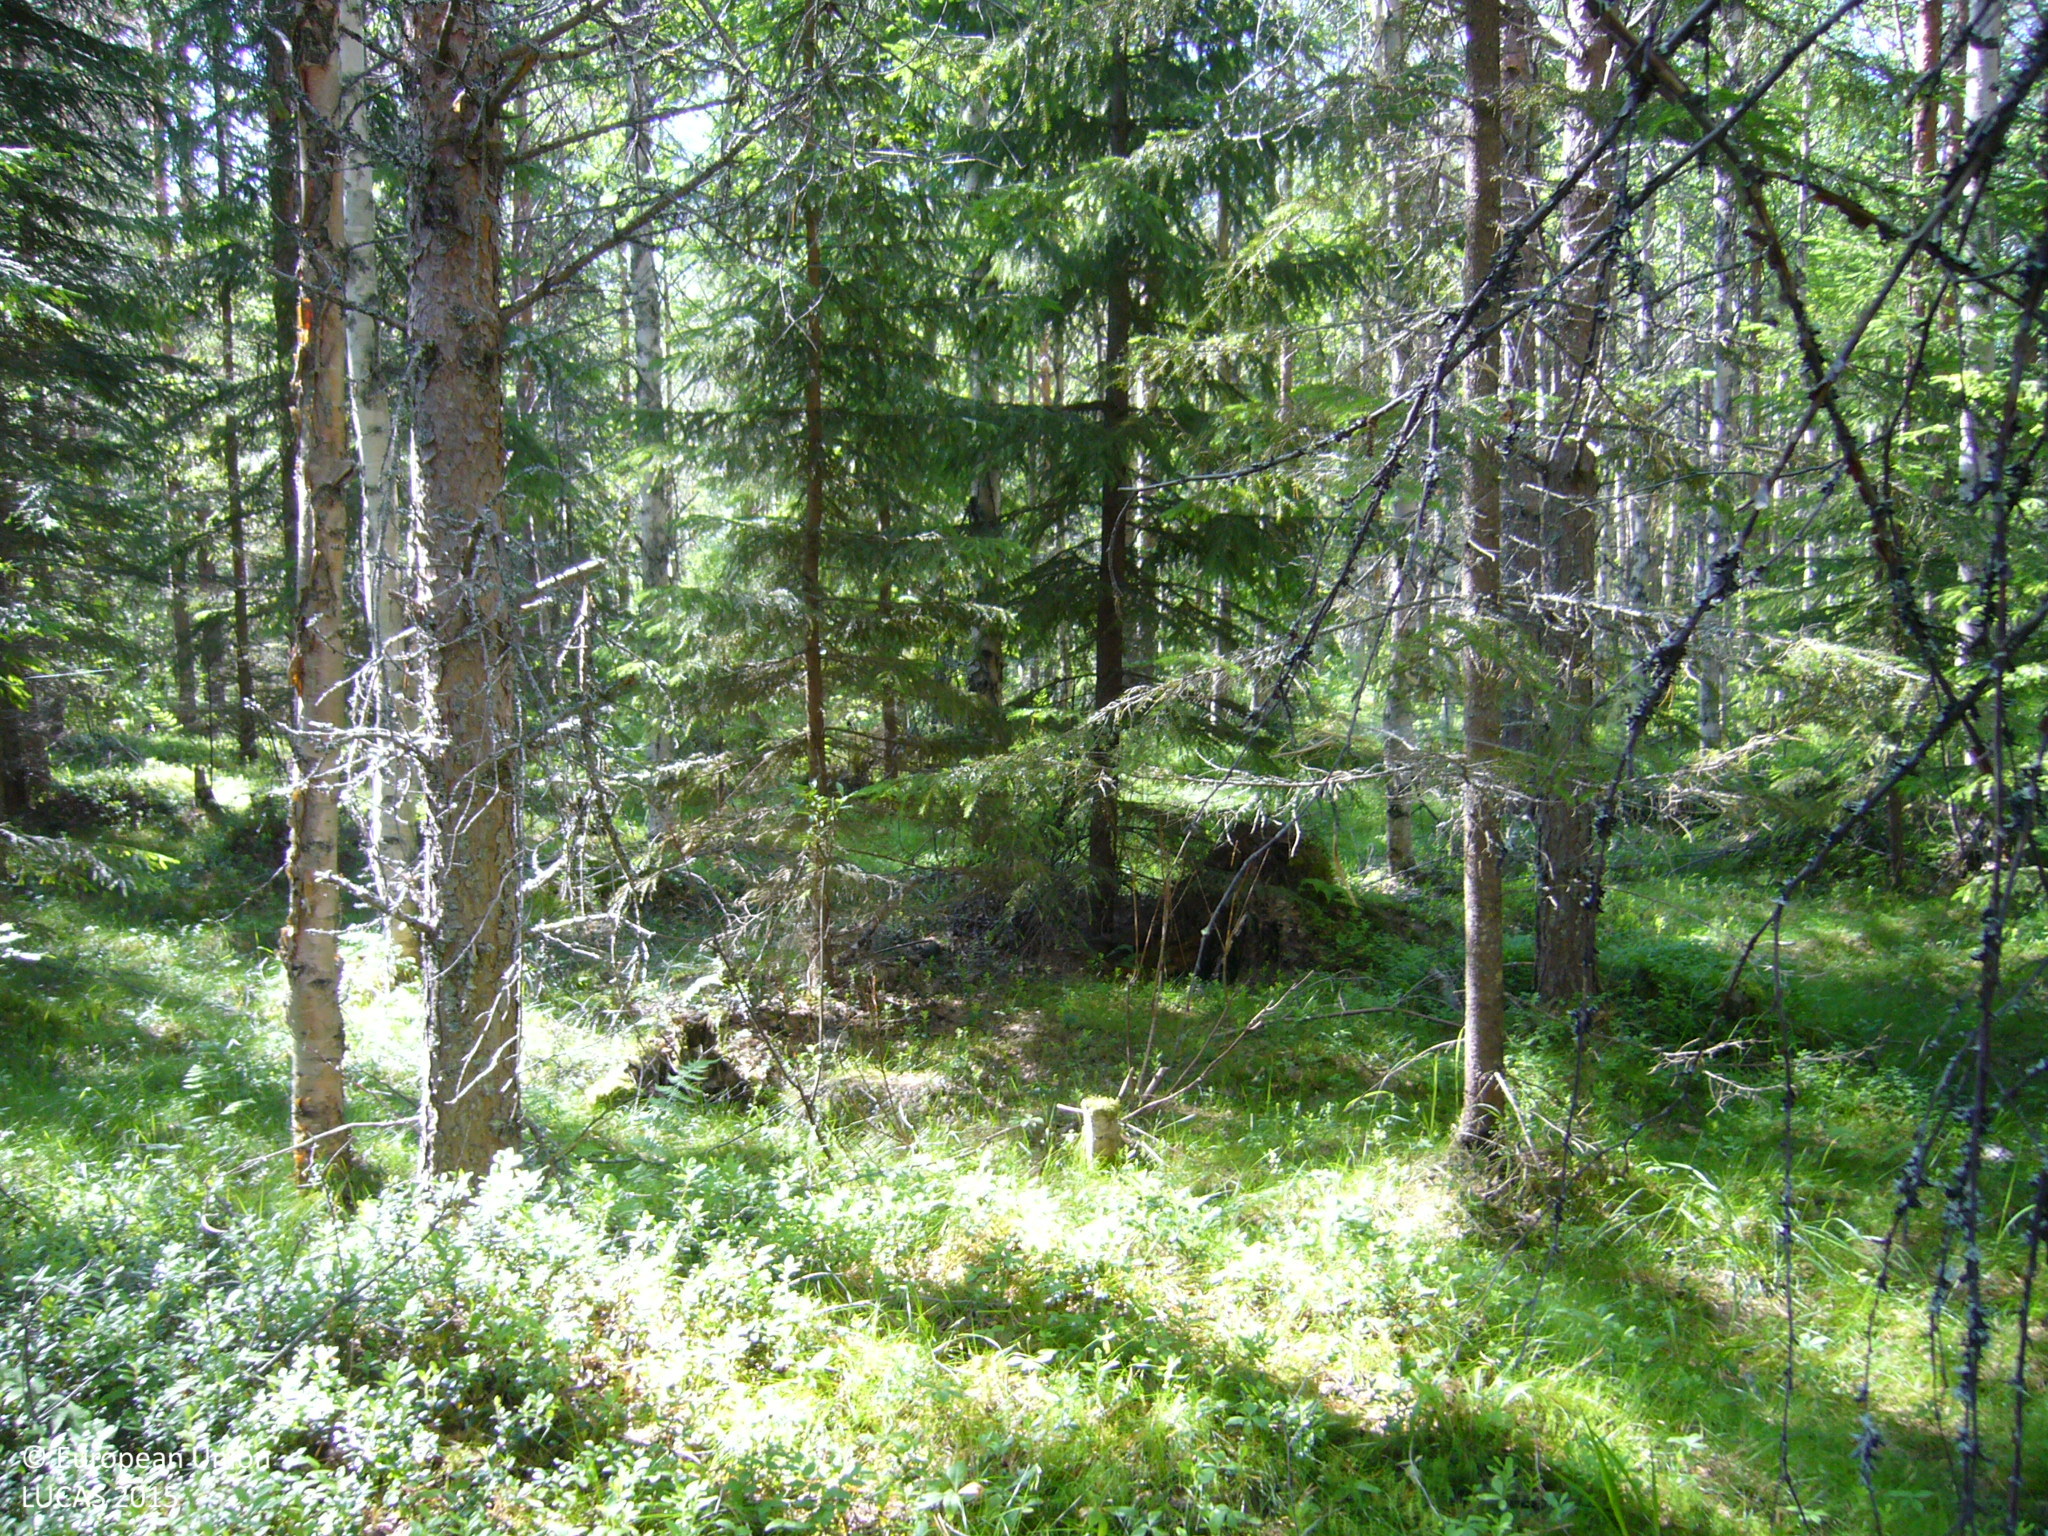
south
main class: Woodland
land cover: Pine dominated mixed woodland
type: boreal forest
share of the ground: > 75 %
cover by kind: coniferous forest trees 50 %, broadleaved forest trees 30 %, shrubs 20 %
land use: Forestry
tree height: > 5 m
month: July
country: FI
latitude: 63.3382
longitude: 25.9953
